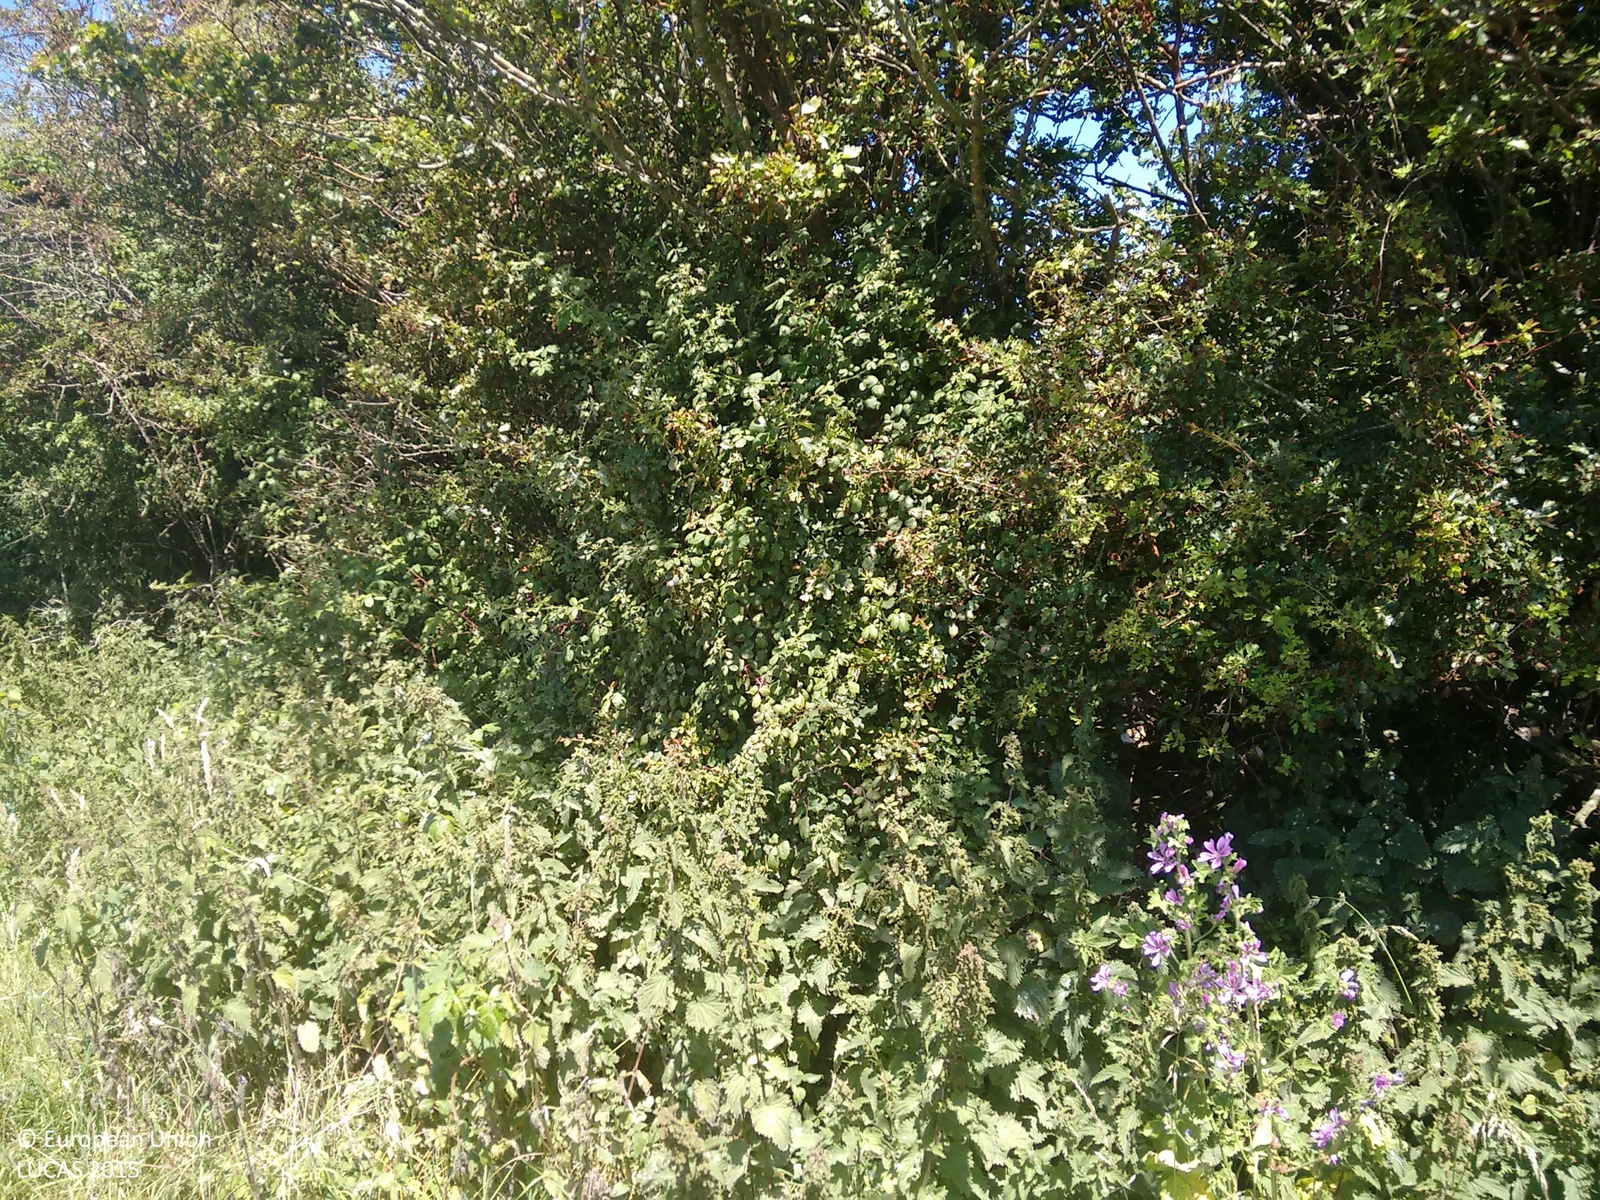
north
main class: Grassland
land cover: Grassland without tree/shrub cover
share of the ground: > 75 %
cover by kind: herbaceous plants 100 %
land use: Agriculture (excluding fallow land and kitchen gardens)
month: June
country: GB
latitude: 50.8352
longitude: -0.3595
